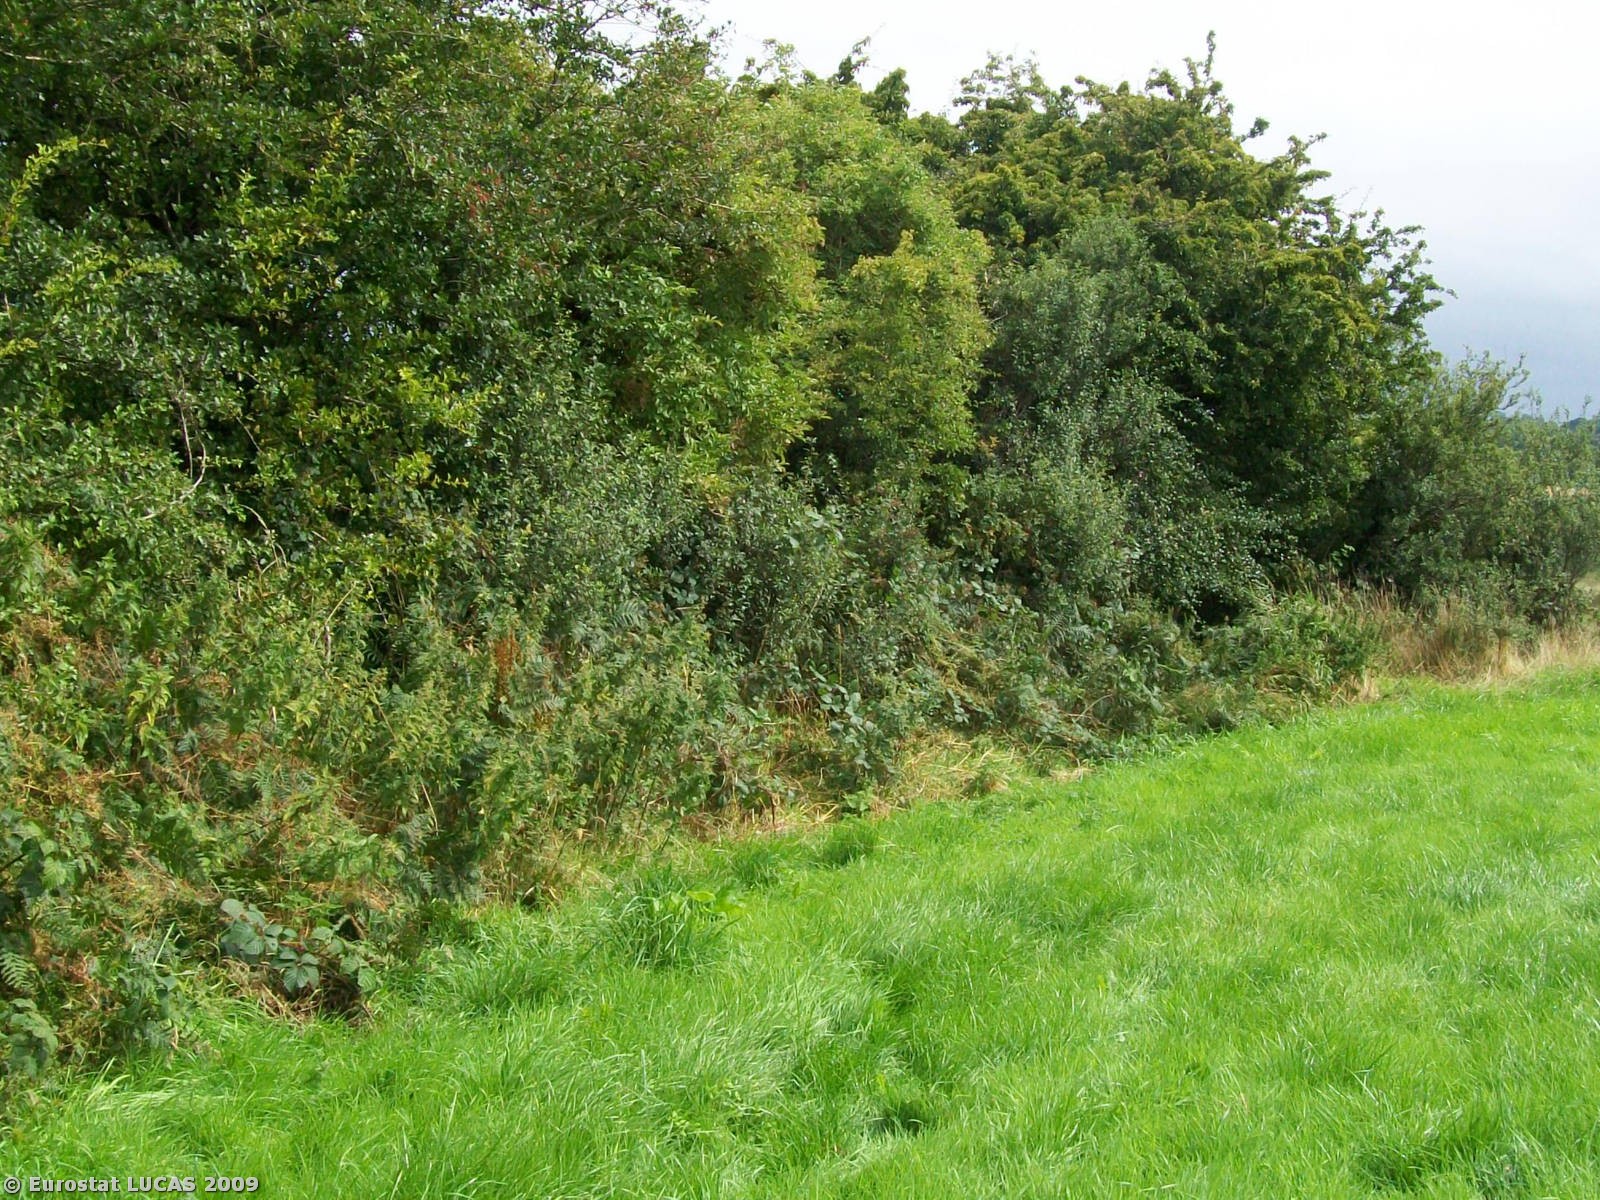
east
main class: Grassland
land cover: Grassland without tree/shrub cover
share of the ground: > 75 %
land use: Agriculture (excluding fallow land and kitchen gardens)
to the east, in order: Grassland without tree/shrub cover; Fences; Broadleaved woodland; Grassland without tree/shrub cover; Spontaneously vegetated surfaces; Inland running water; Grass margins; Spontaneously vegetated surfaces; Grassland without tree/shrub cover; Broadleaved woodland; Grassland without tree/shrub cover; Broadleaved woodland; Grassland without tree/shrub cover
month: August
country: GB
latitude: 54.4867
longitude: -6.0574
